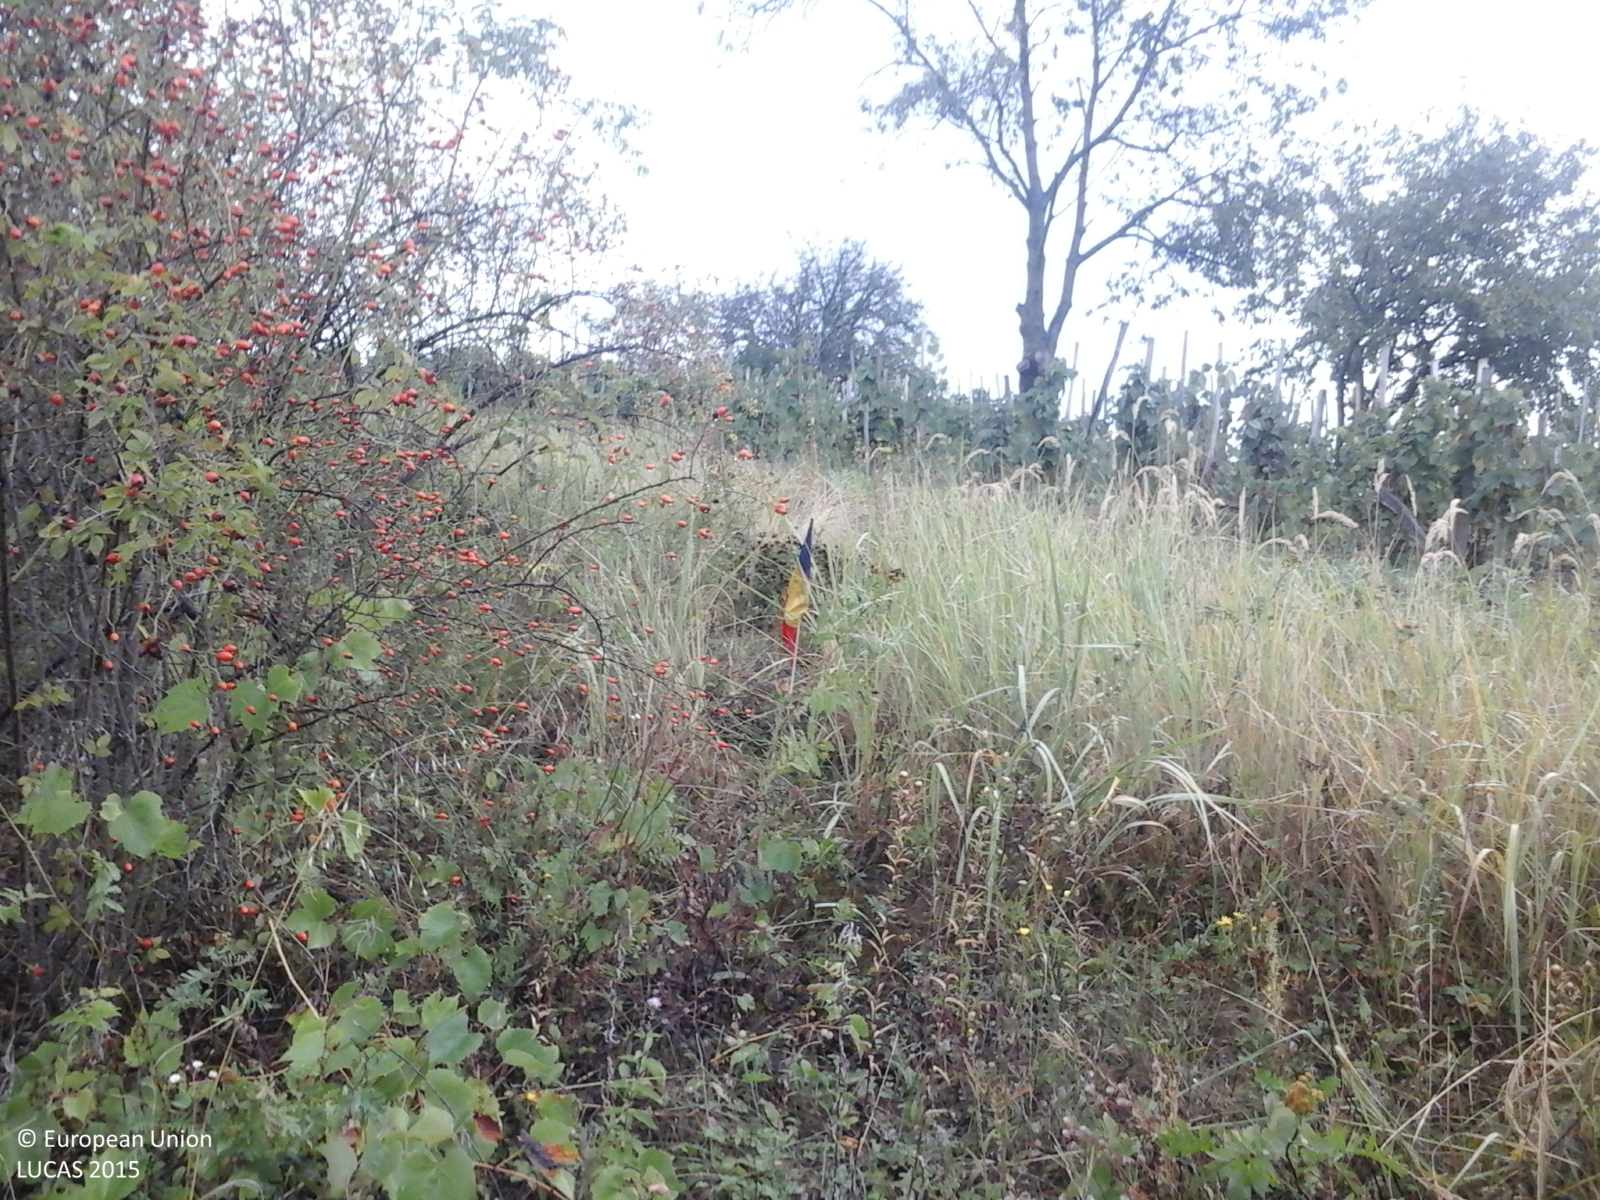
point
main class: Grassland
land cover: Grassland with sparse tree/shrub cover
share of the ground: > 75 %
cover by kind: herbaceous plants 85 %, shrubs 10 %, broadleaved forest trees 5 %
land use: Fallow land
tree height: < 5 m
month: September
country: RO
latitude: 47.3698
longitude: 22.5986
